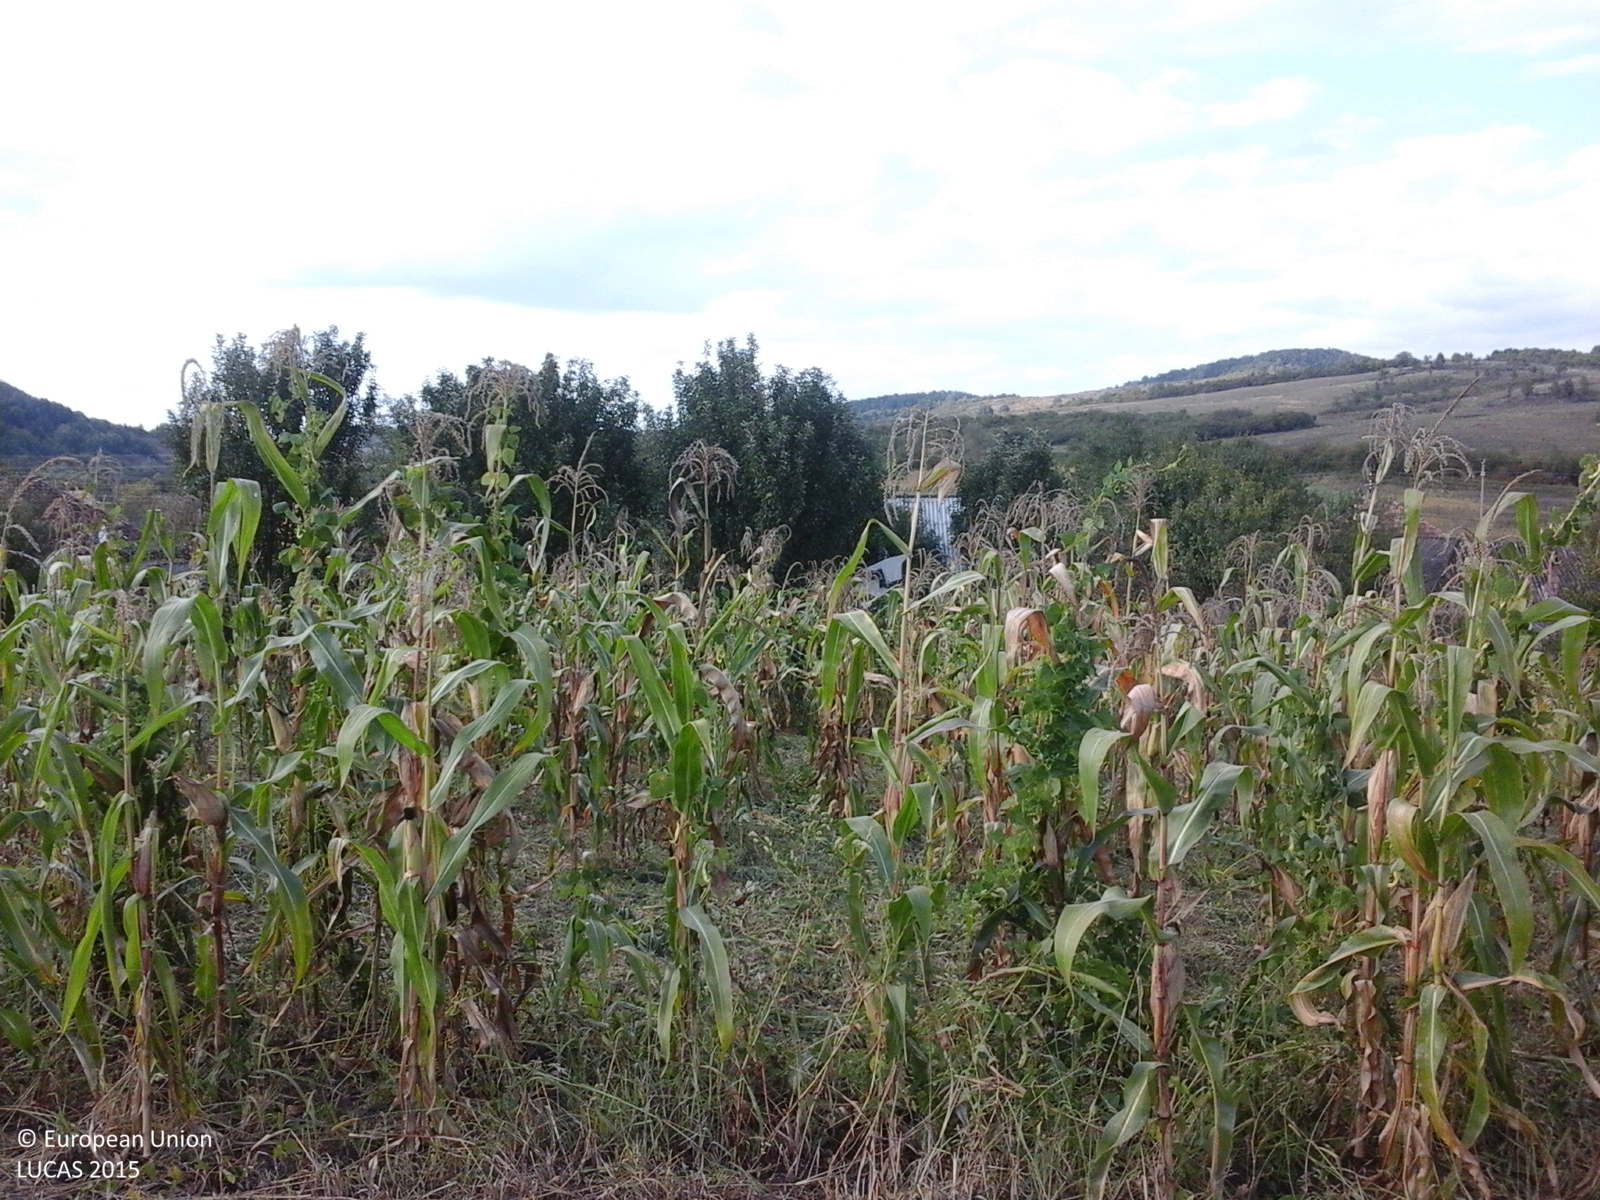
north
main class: Grassland
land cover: Grassland without tree/shrub cover
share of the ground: > 75 %
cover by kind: herbaceous plants 100 %
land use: Agriculture (excluding fallow land and kitchen gardens)
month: September
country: RO
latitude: 47.2980
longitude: 23.1994
